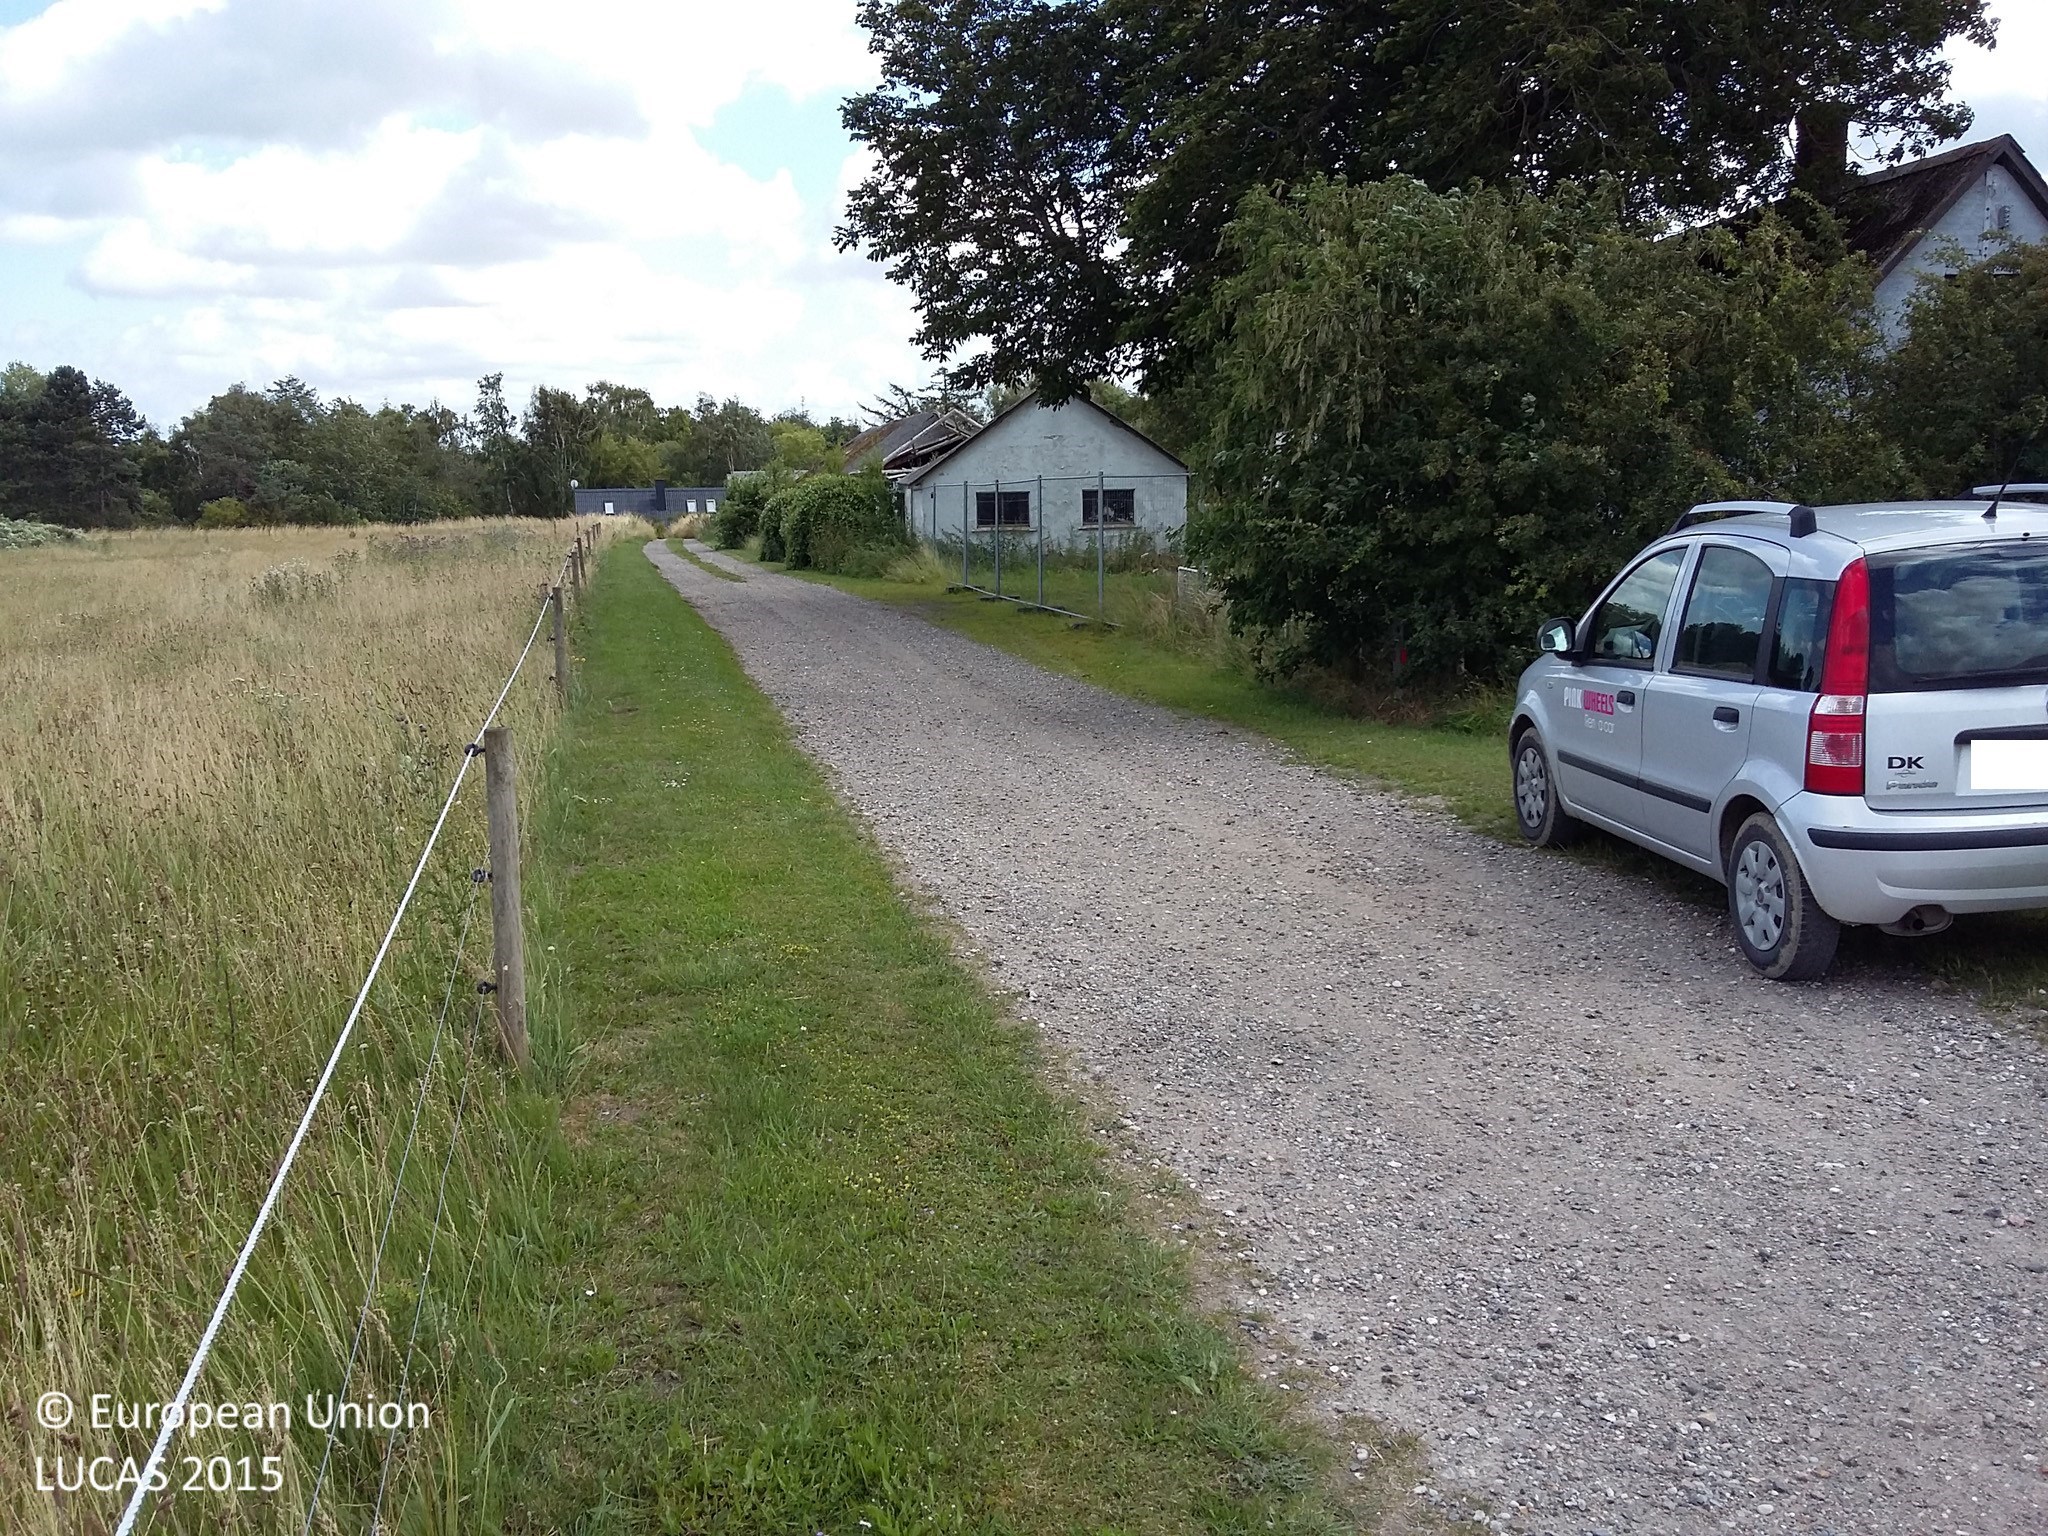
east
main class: Grassland
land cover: Grassland without tree/shrub cover
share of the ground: > 75 %
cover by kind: herbaceous plants 100 %
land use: Agriculture (excluding fallow land and kitchen gardens)
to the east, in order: Grassland without tree/shrub cover; Fences; Grassland without tree/shrub cover; Artificial constructions in urban areas
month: July
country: DK
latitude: 55.7625
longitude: 11.7355
